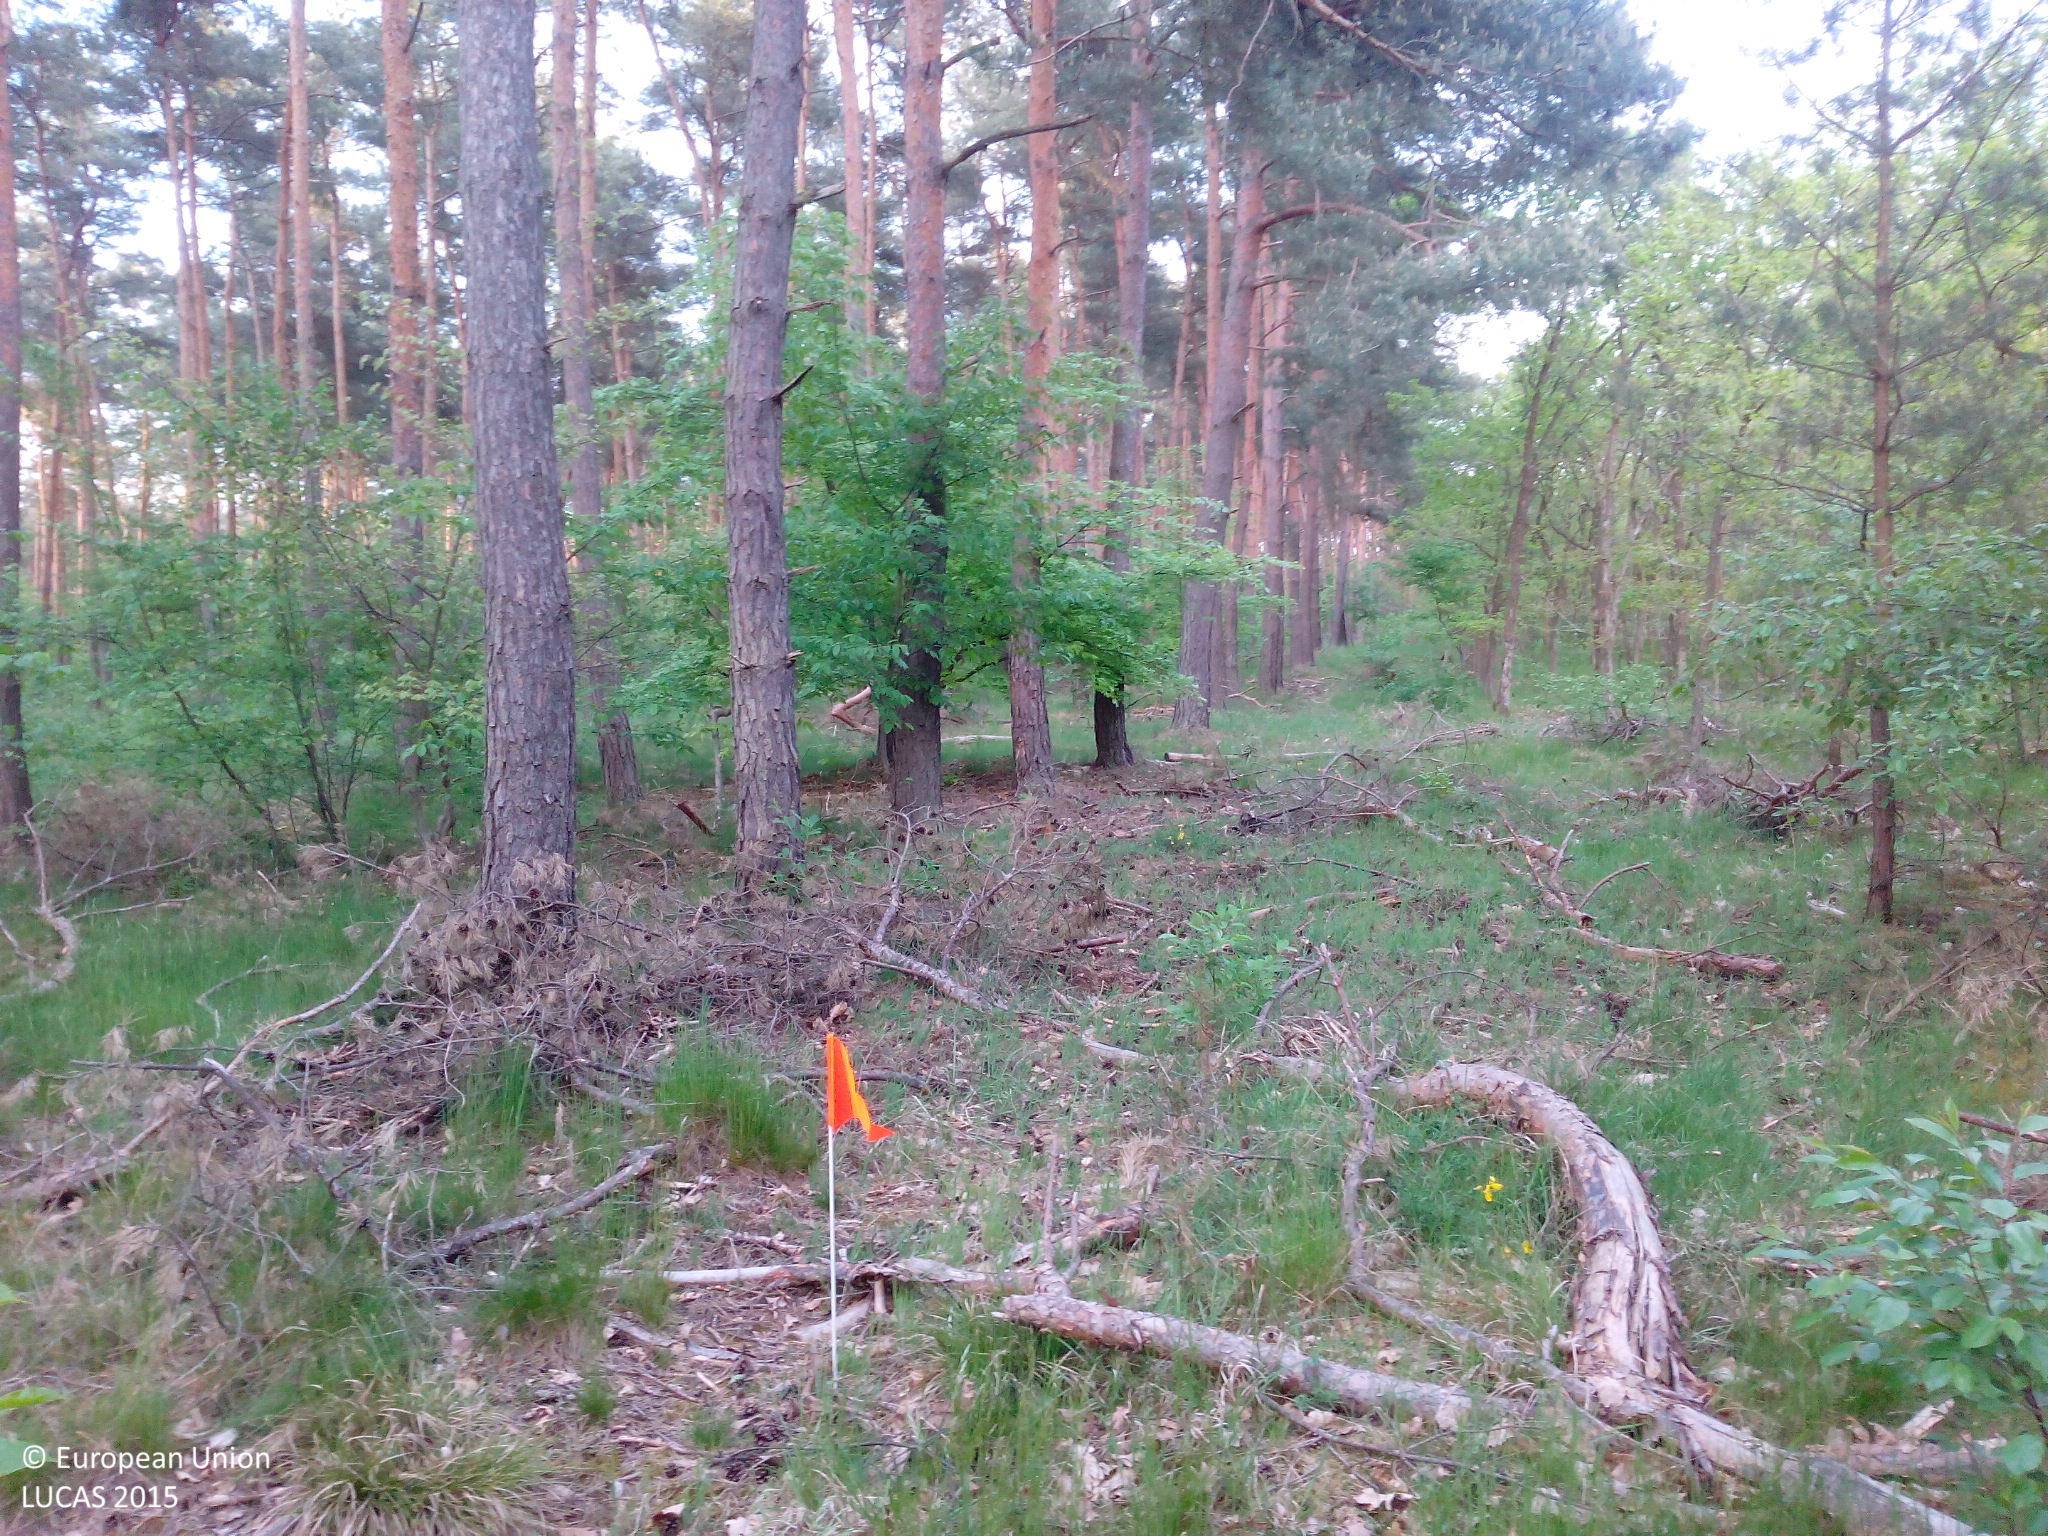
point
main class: Woodland
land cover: Pine dominated coniferous woodland
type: hemiboreal forest and nemoral coniferous forest and mixed broadleaved-coniferous forest
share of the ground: > 75 %
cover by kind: coniferous forest trees 60 %, herbaceous plants 20 %, broadleaved forest trees 15 %, unconsolidated bare surface 5 %
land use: Forestry
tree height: > 5 m
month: May
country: DE
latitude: 49.5994
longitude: 8.5477
